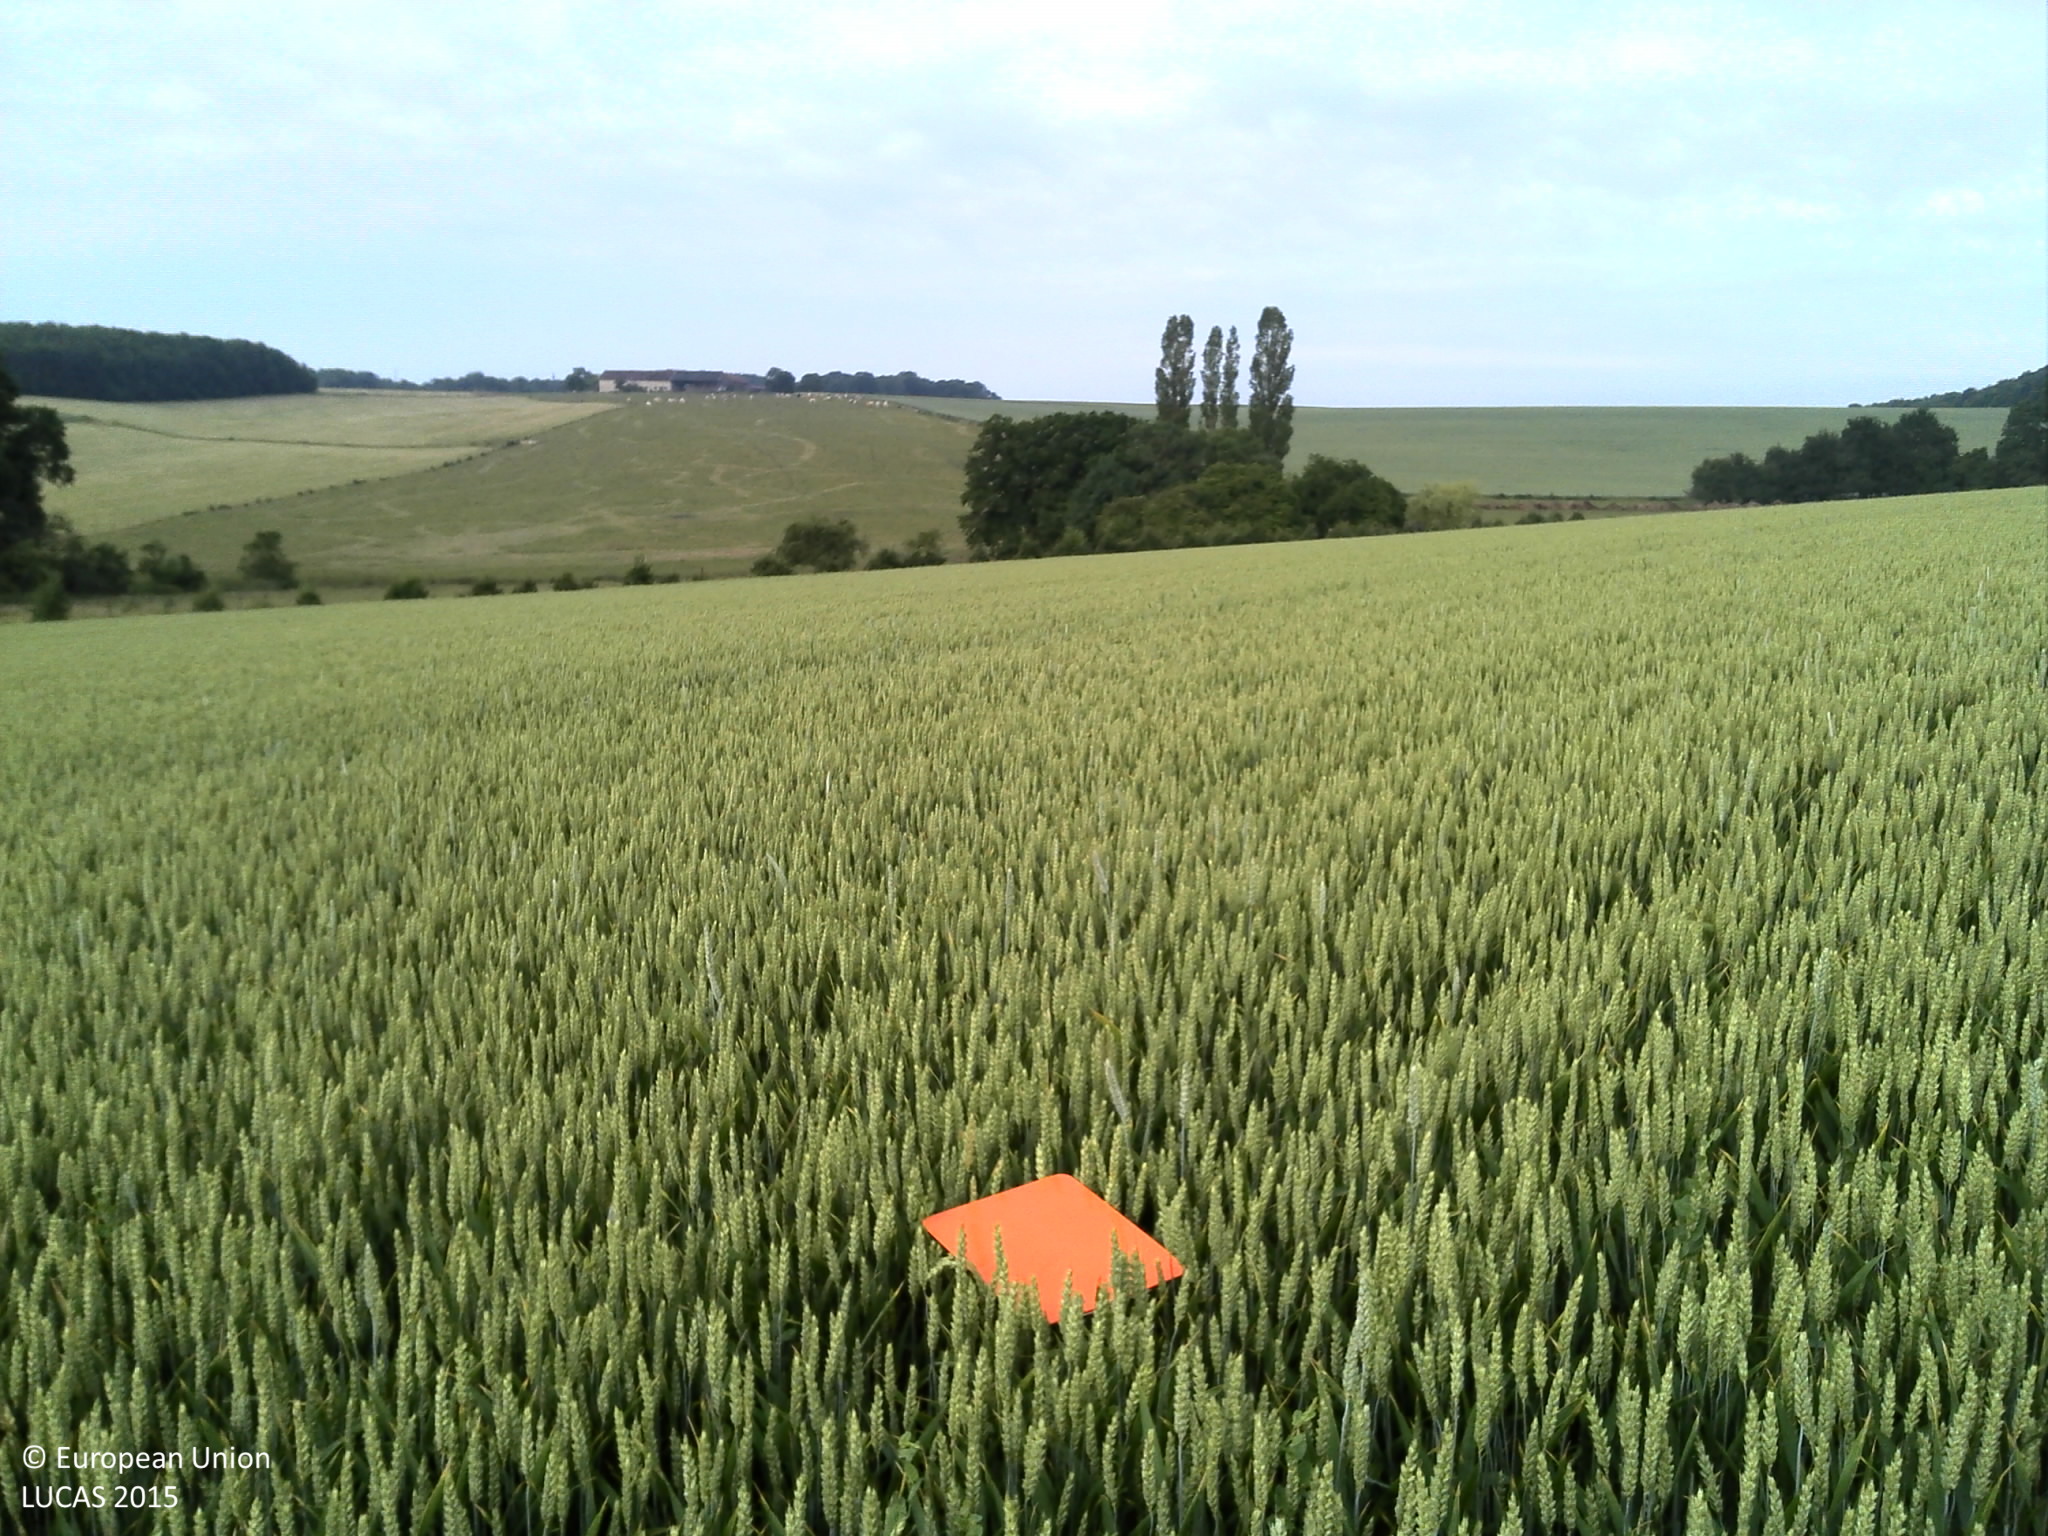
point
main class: Cropland
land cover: Common wheat
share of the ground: > 75 %
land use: Agriculture (excluding fallow land and kitchen gardens)
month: June
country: FR
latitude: 49.3754
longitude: 5.0808
